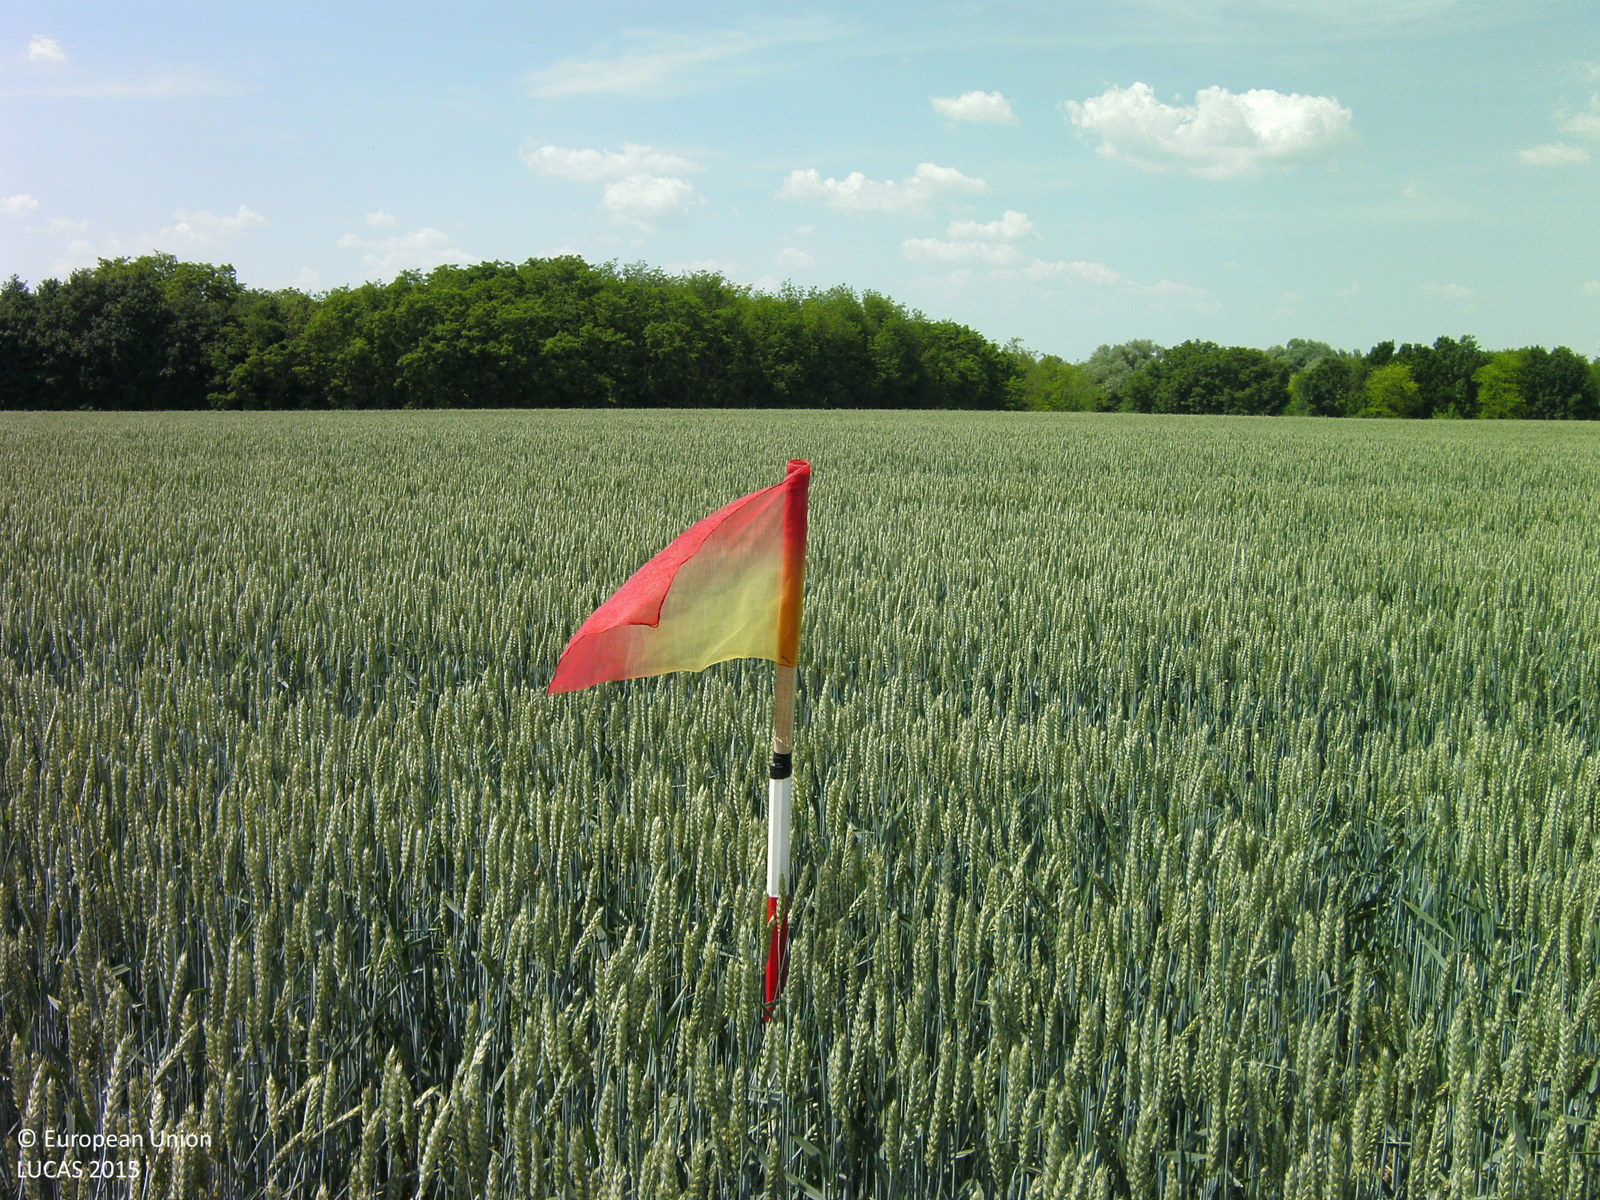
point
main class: Cropland
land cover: Durum wheat
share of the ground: > 75 %
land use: Agriculture (excluding fallow land and kitchen gardens)
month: June
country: HU
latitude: 46.3958
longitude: 17.7440
